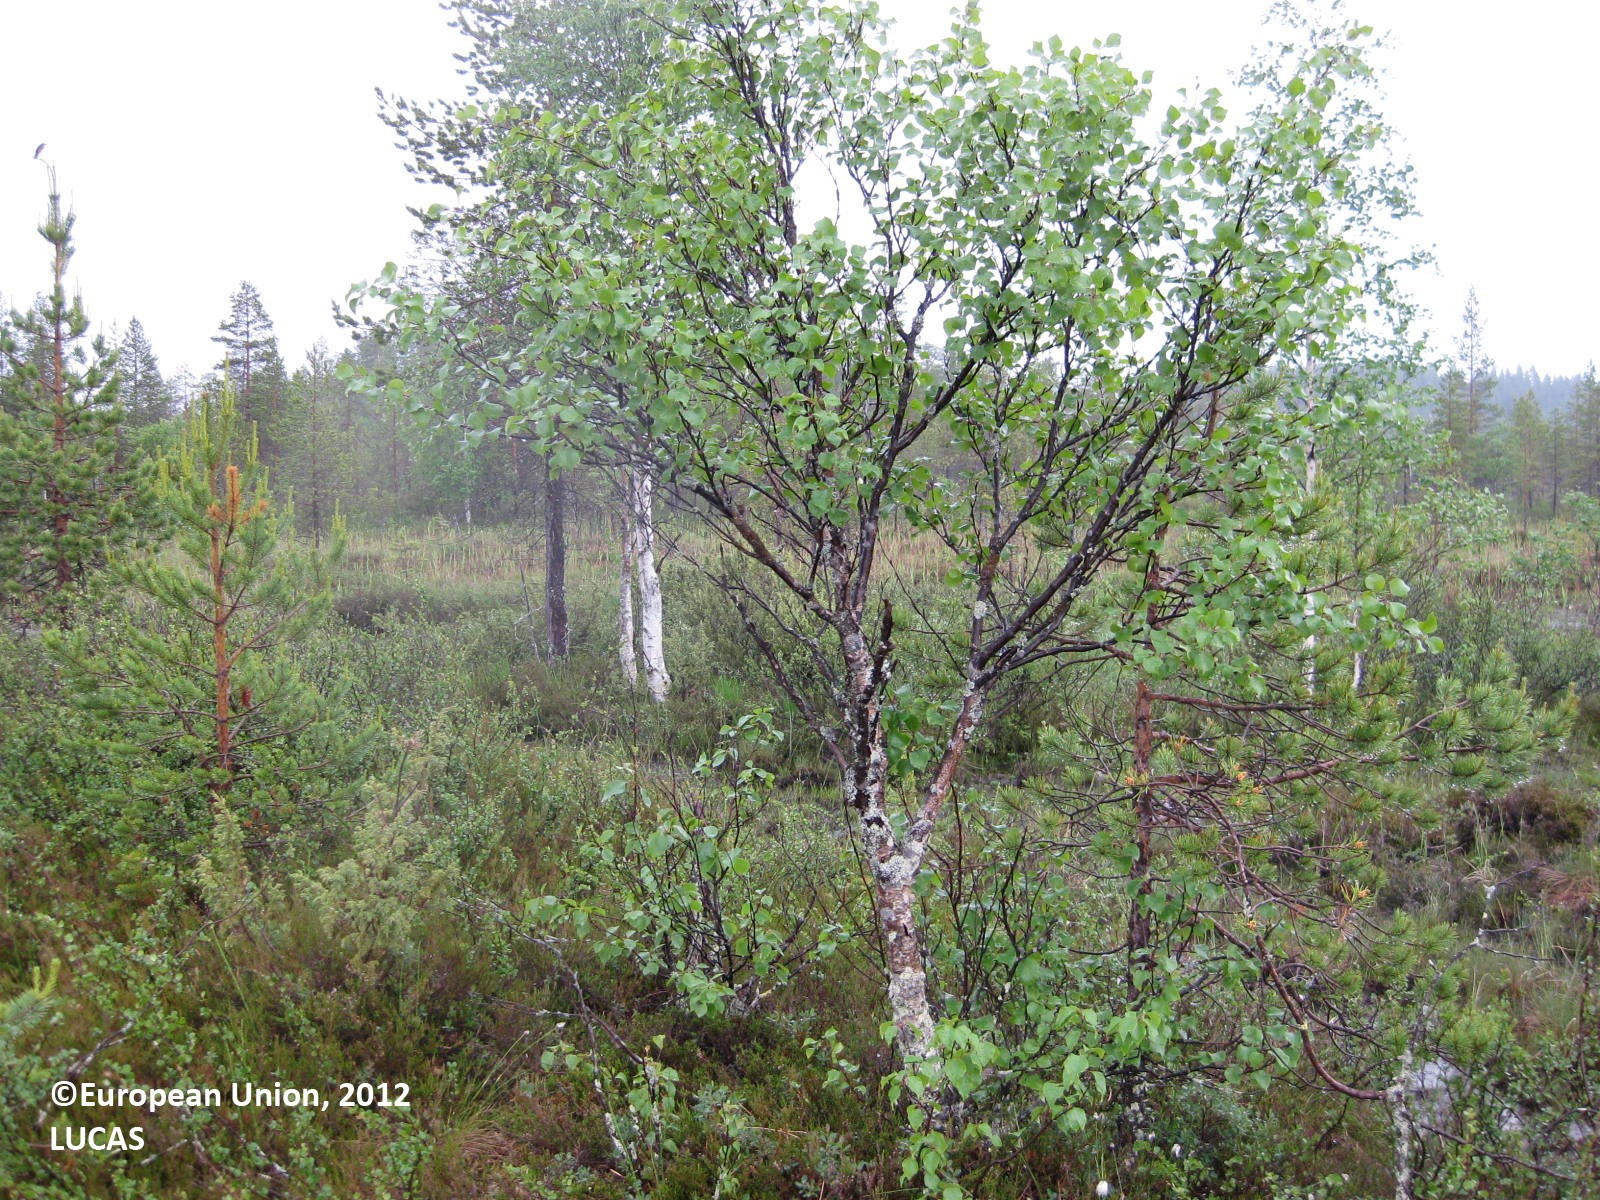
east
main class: Woodland
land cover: Pine dominated mixed woodland
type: boreal forest
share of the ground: 10 - 25 %
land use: Semi-natural and natural areas not in use
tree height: > 5 m
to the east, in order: Pine dominated mixed woodland; Pine dominated coniferous woodland; Other coniferous woodland; Pine dominated coniferous woodland
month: July
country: FI
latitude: 65.6702
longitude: 29.4448
